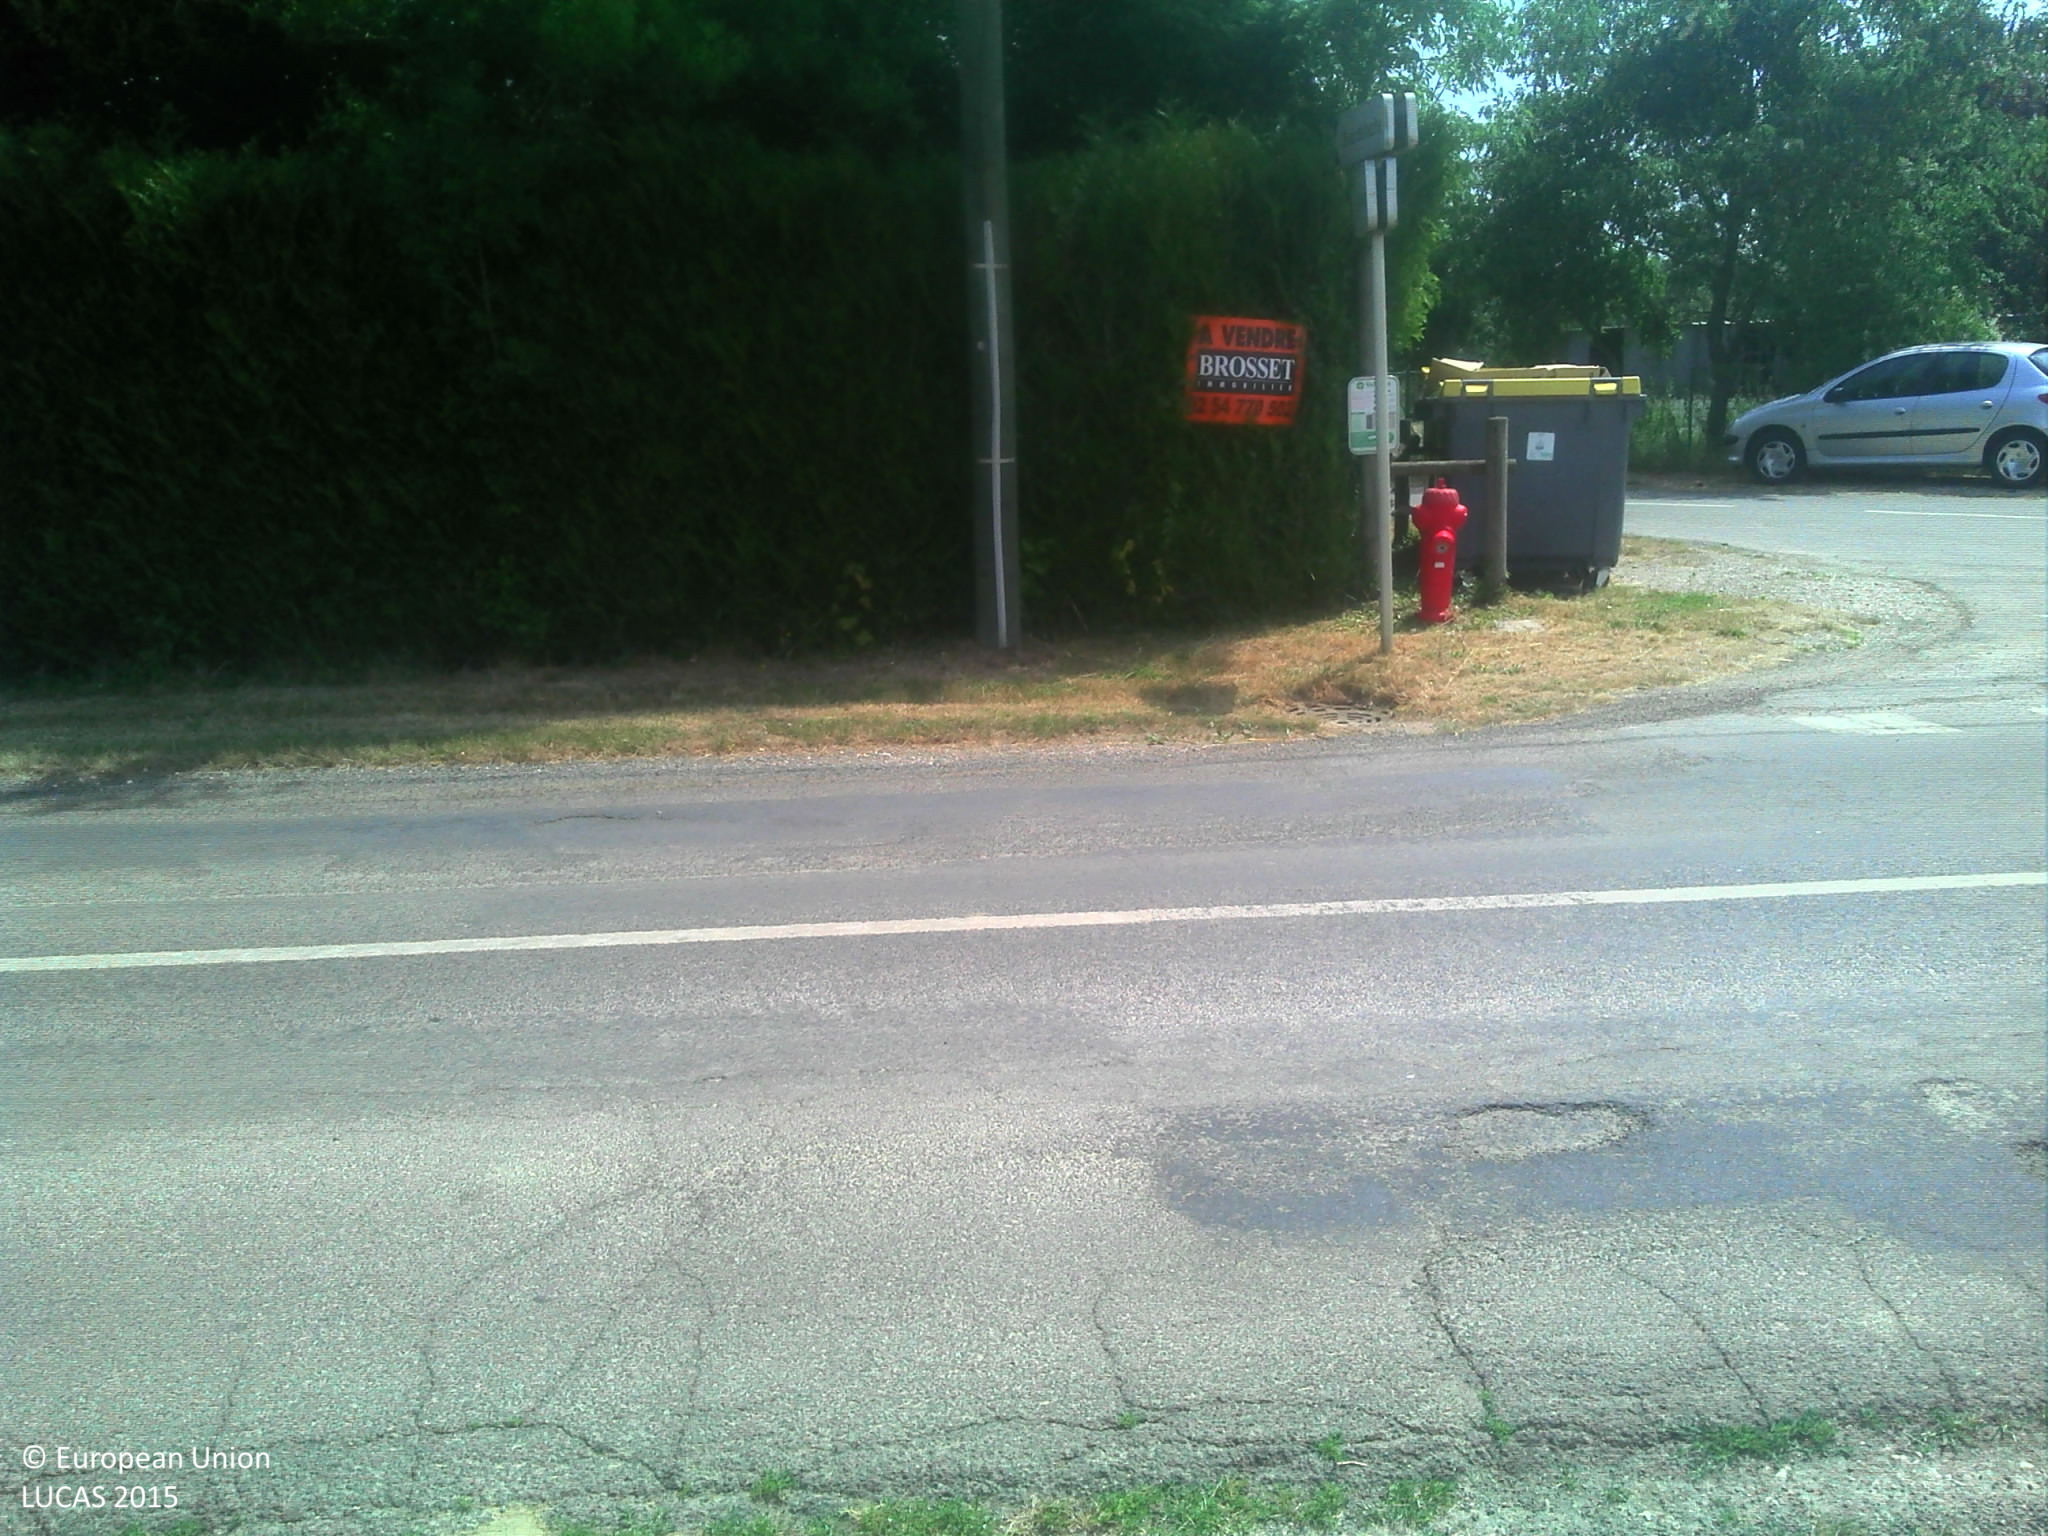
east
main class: Cropland
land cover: Common wheat
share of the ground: > 75 %
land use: Agriculture (excluding fallow land and kitchen gardens)
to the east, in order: Common wheat; Grass margins; Artificial constructions in urban areas; Durum wheat
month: July
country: FR
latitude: 47.6974
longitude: 1.0679
